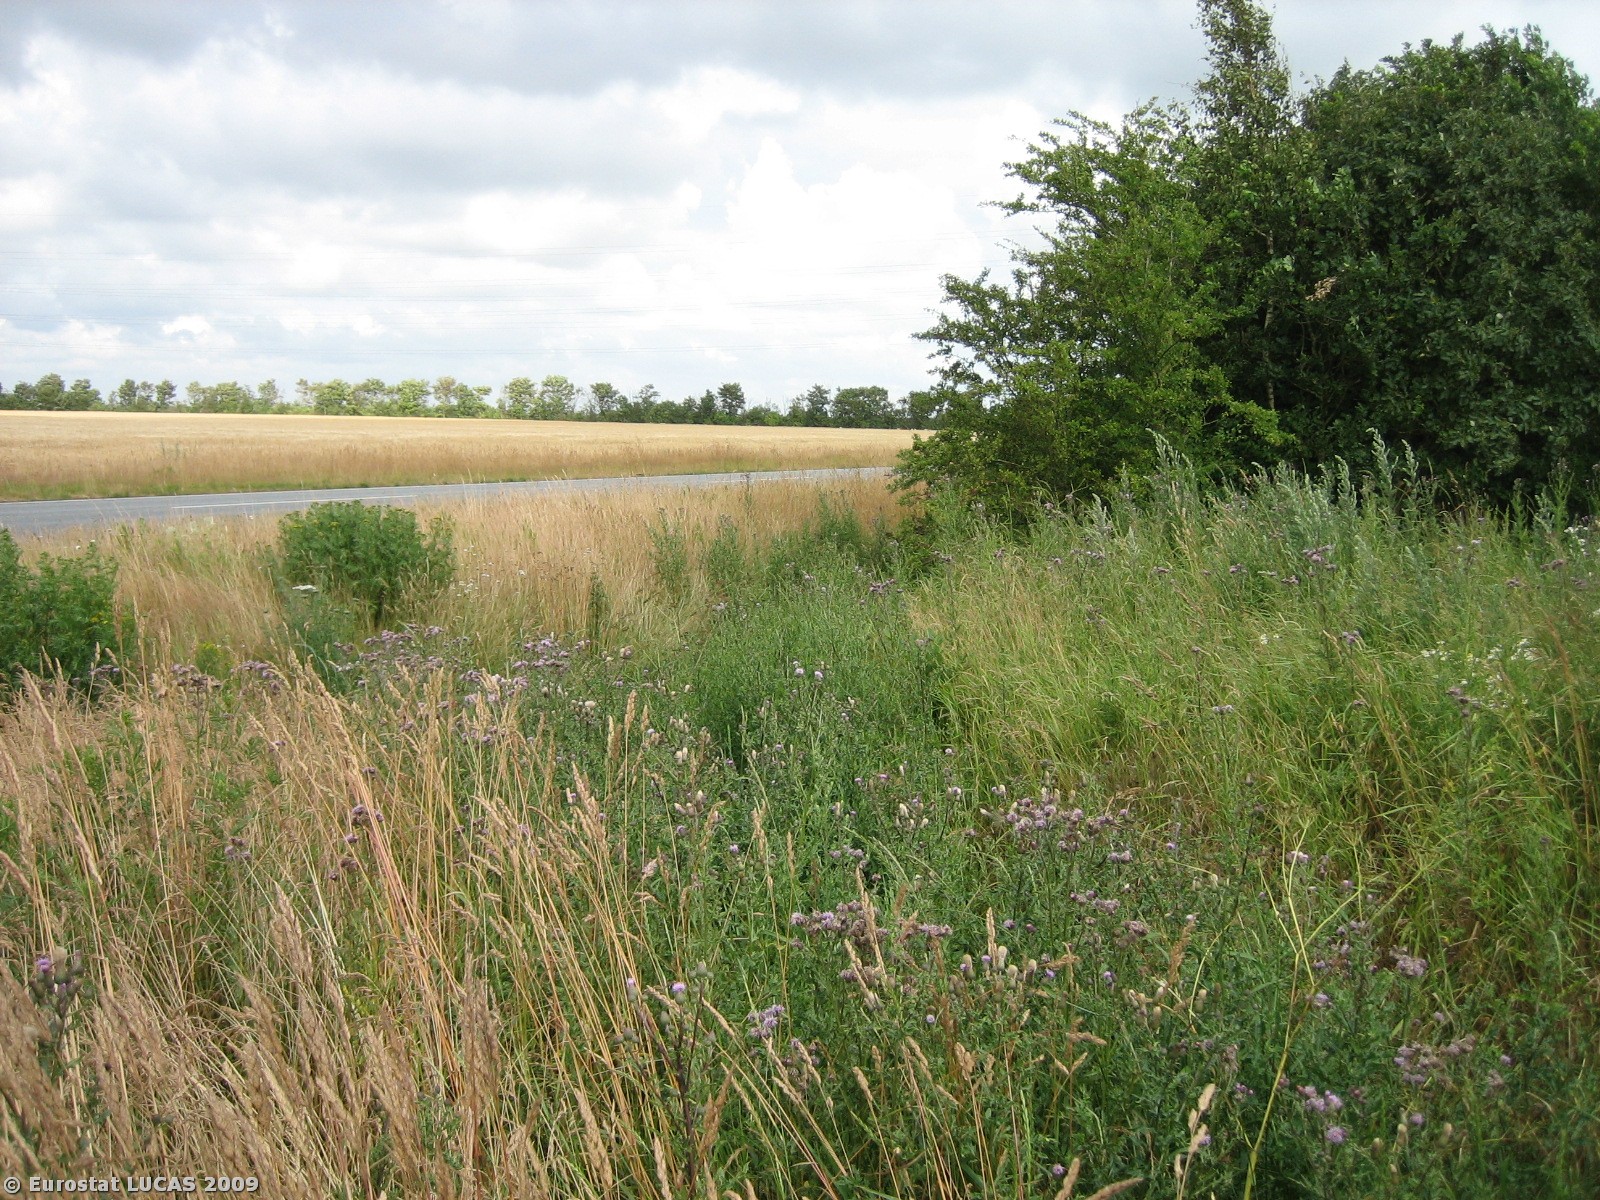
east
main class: Cropland
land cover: Rape and turnip rape
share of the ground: > 75 %
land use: Agriculture (excluding fallow land and kitchen gardens)
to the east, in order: Rape and turnip rape; Broadleaved woodland; Grass margins; Ditches and canals; Grass margins; Paved roads, cycling and walking lanes; Grass margins; Ditches and canals; Grass margins; Barley; Broadleaved woodland; Barley
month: July
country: DK
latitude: 55.5138
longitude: 8.4969
